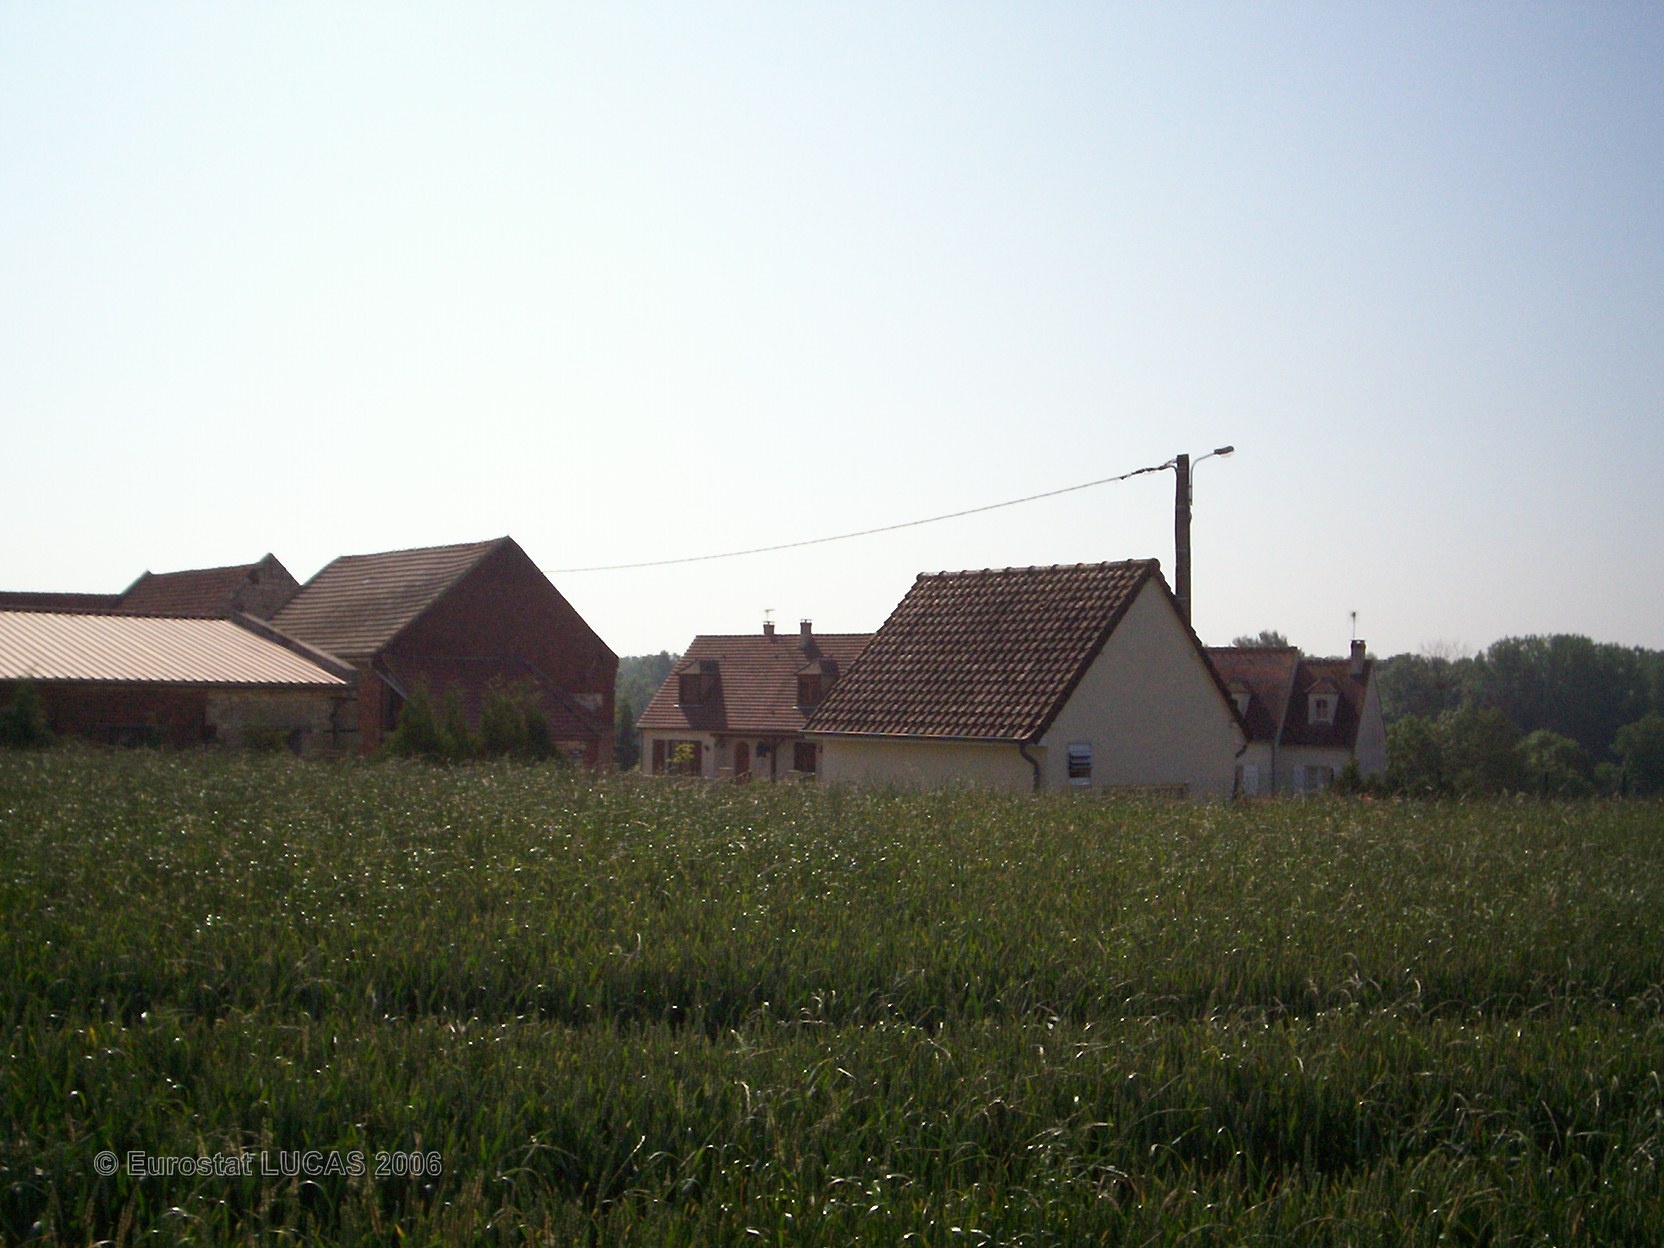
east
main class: Cropland
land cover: Common wheat
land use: Agriculture (excluding fallow land and kitchen gardens)
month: June
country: FR
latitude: 49.4959
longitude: 2.6574
